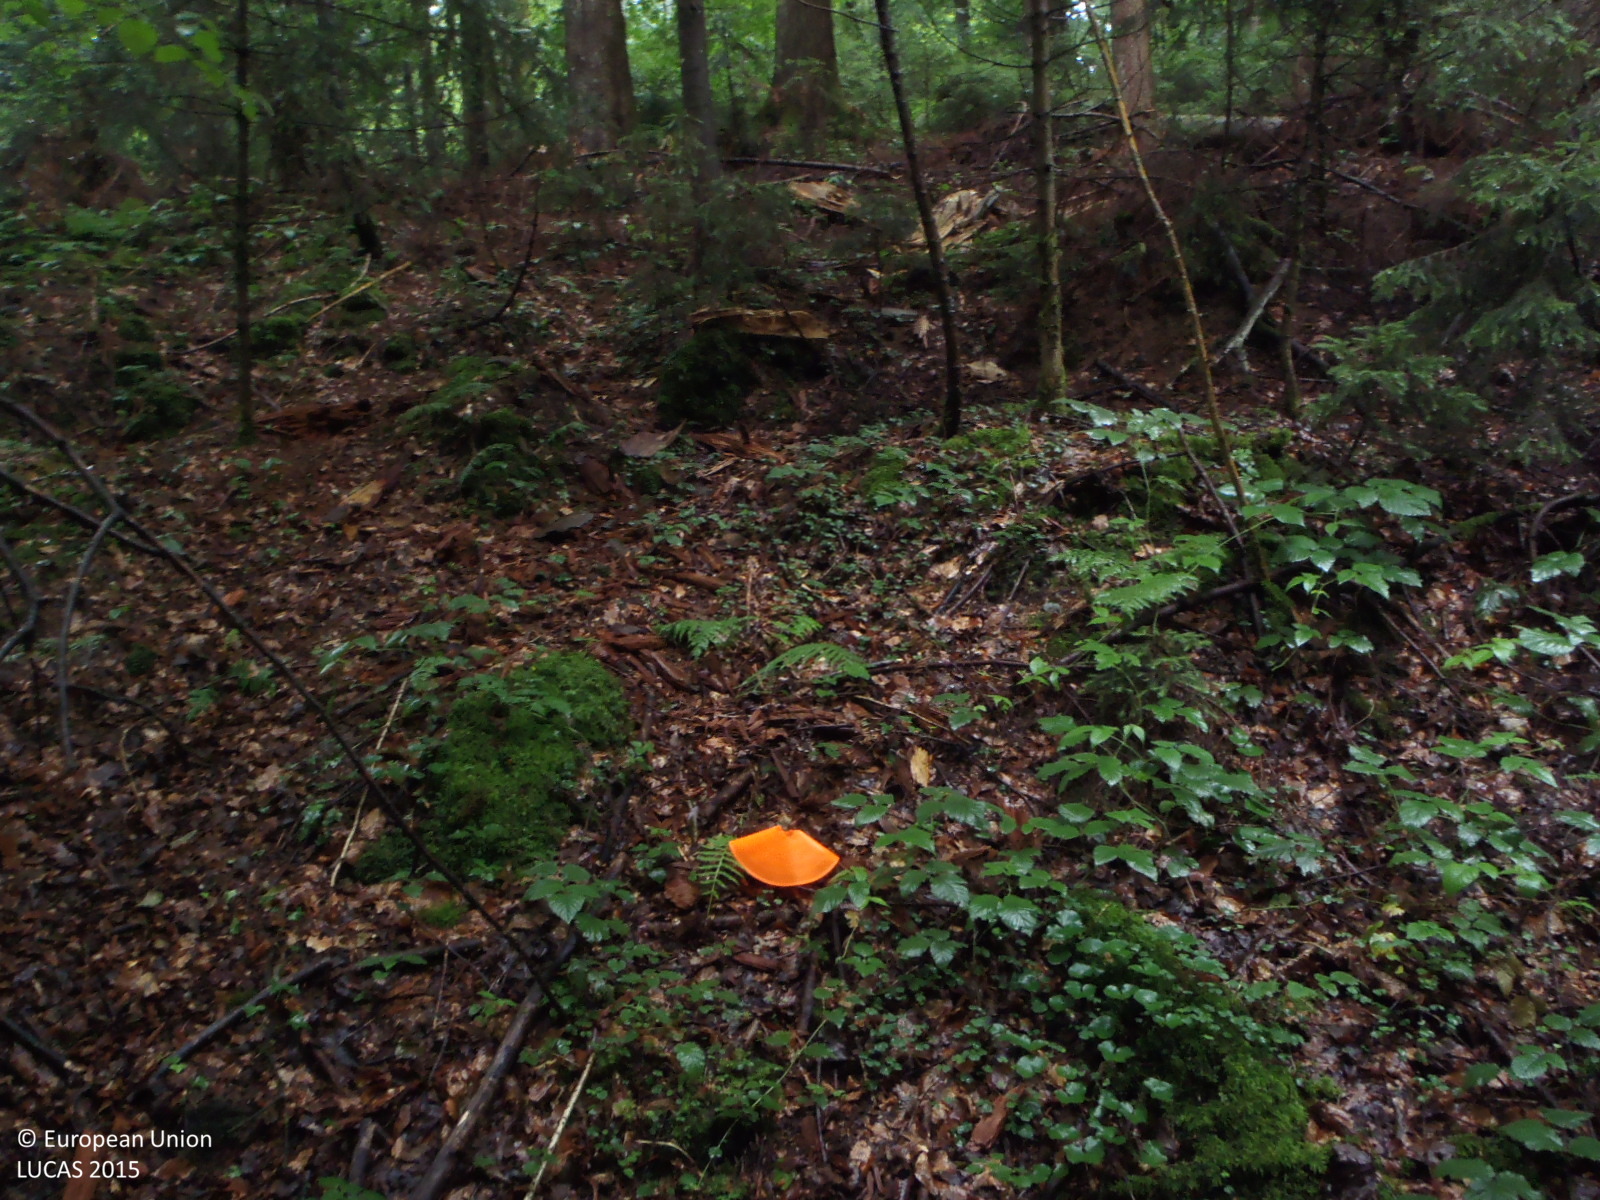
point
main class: Woodland
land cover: Broadleaved woodland
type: mountainous beech forest
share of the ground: > 75 %
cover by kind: broadleaved forest trees 80 %, coniferous forest trees 20 %
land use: Forestry
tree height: > 5 m
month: July
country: AT
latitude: 47.6610
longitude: 12.2223
